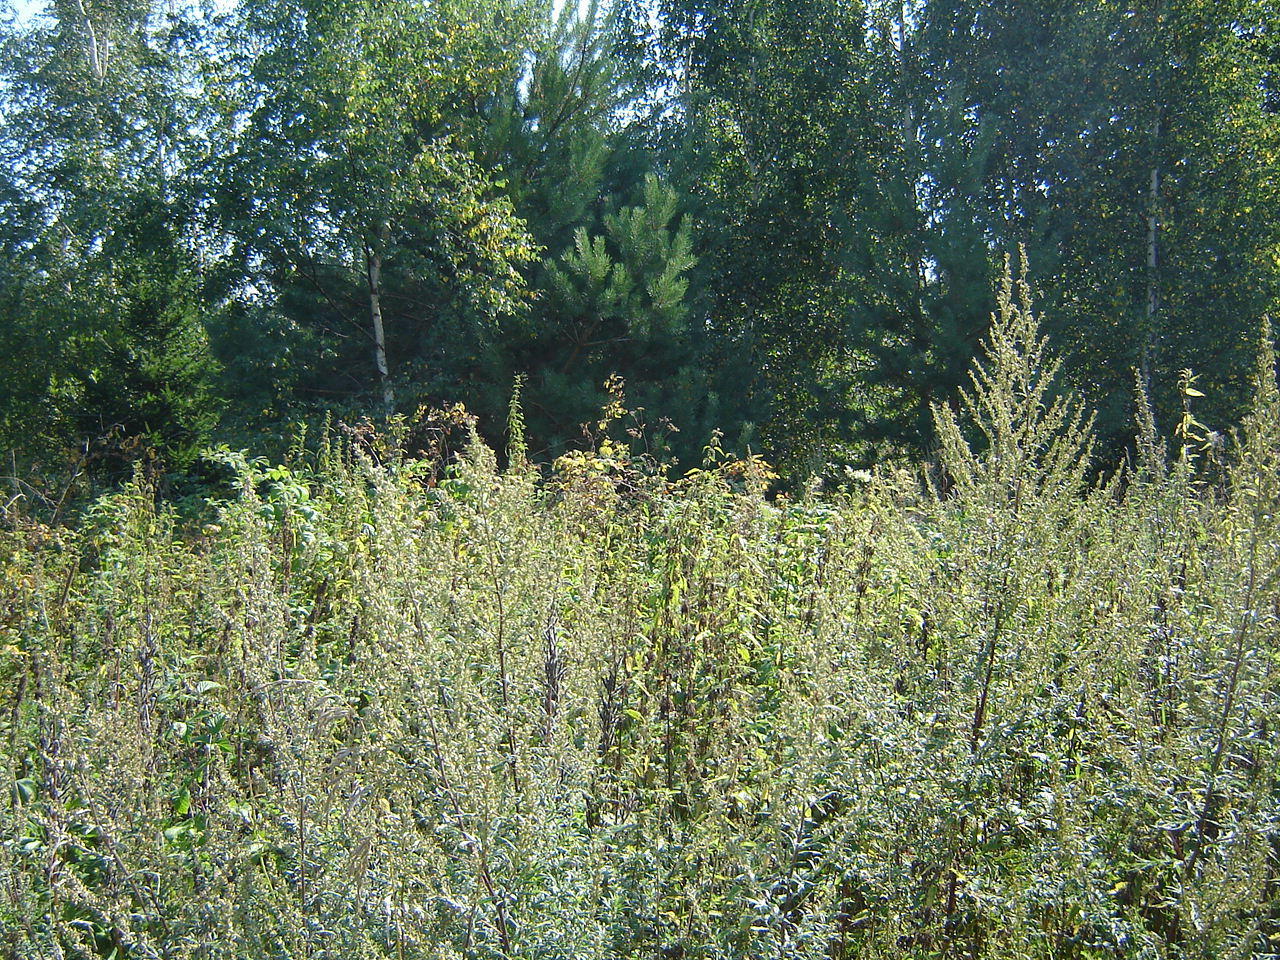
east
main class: Woodland
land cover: Pine dominated mixed woodland
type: hemiboreal forest and nemoral coniferous forest and mixed broadleaved-coniferous forest
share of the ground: > 75 %
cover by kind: coniferous forest trees 45 %, broadleaved forest trees 45 %, herbaceous plants 10 %
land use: Forestry
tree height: > 5 m
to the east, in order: Pine dominated mixed woodland; Spontaneously vegetated surfaces; Broadleaved woodland; Inland fresh running water; Broadleaved woodland; Spruce dominated mixed woodland
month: August
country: LT
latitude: 54.8858
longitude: 24.7775
